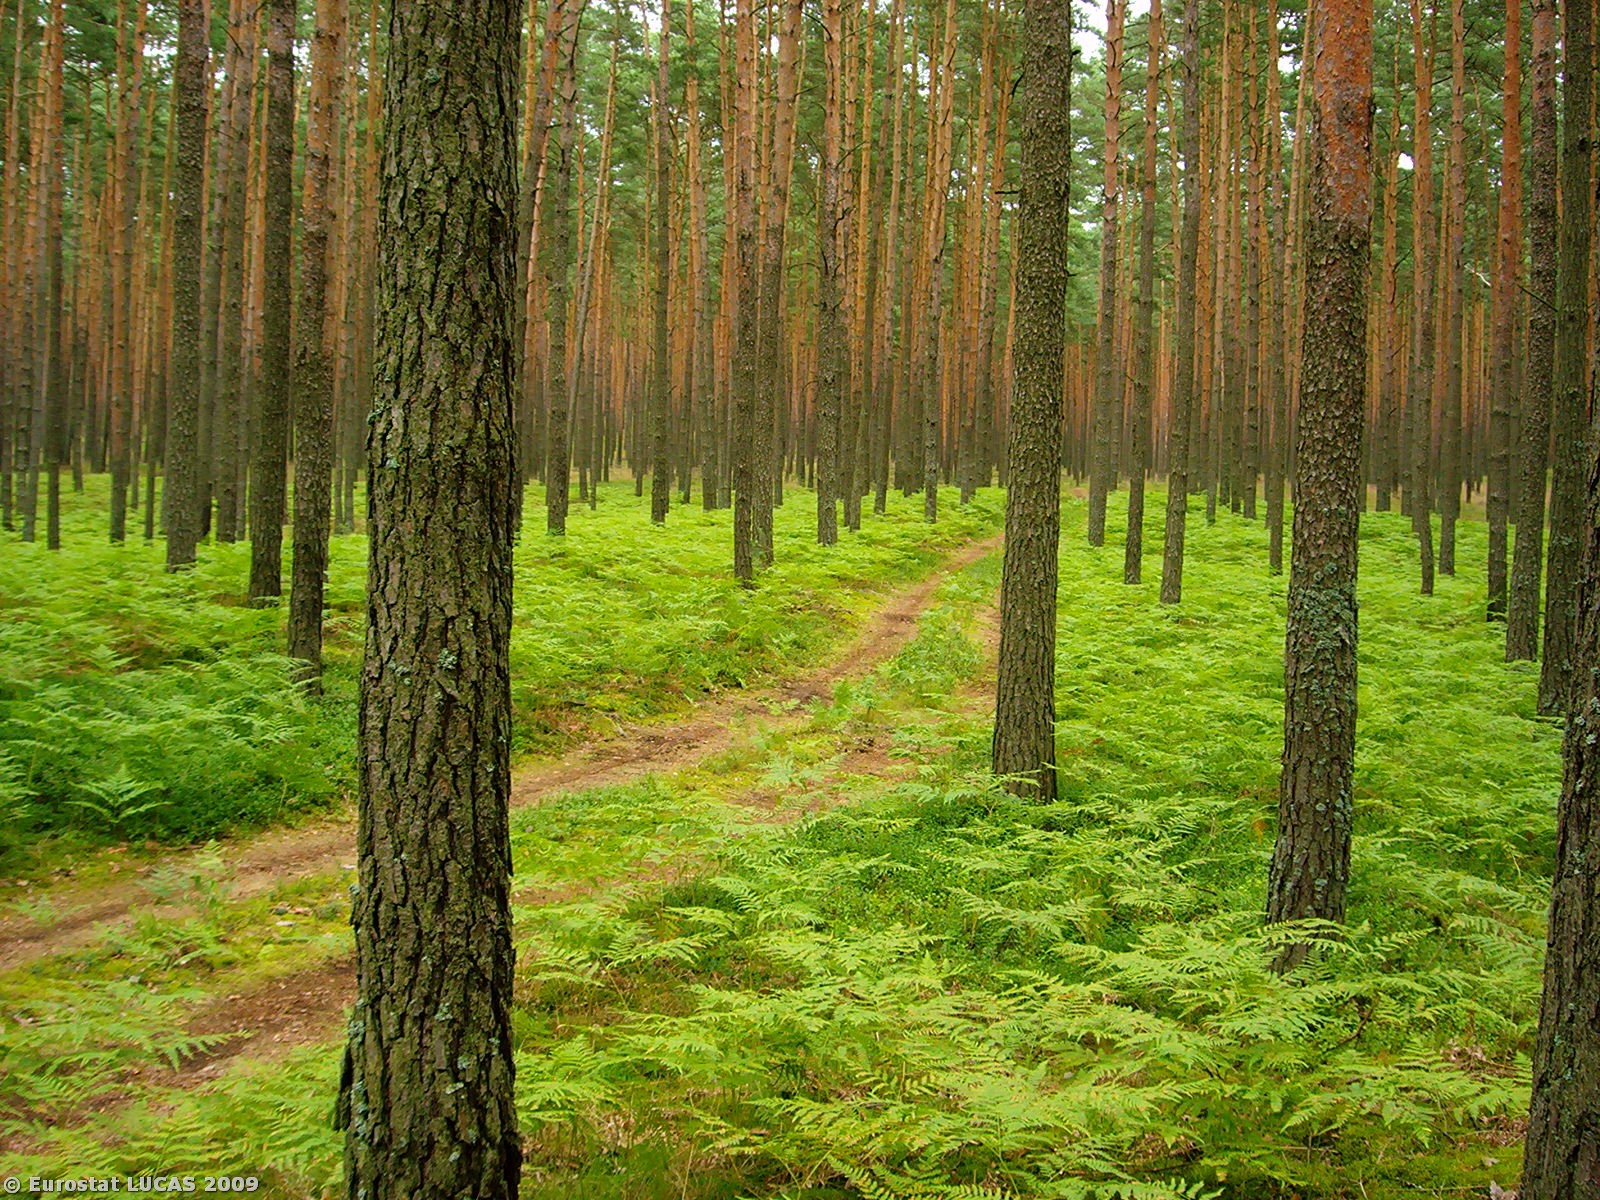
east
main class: Woodland
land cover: Coniferous woodland
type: hemiboreal forest and nemoral coniferous forest and mixed broadleaved-coniferous forest
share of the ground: 50 - 75 %
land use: Forestry
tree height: > 5 m
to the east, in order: Coniferous woodland; Tracks; Coniferous woodland
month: July
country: PL
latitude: 52.5488
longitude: 15.2680
